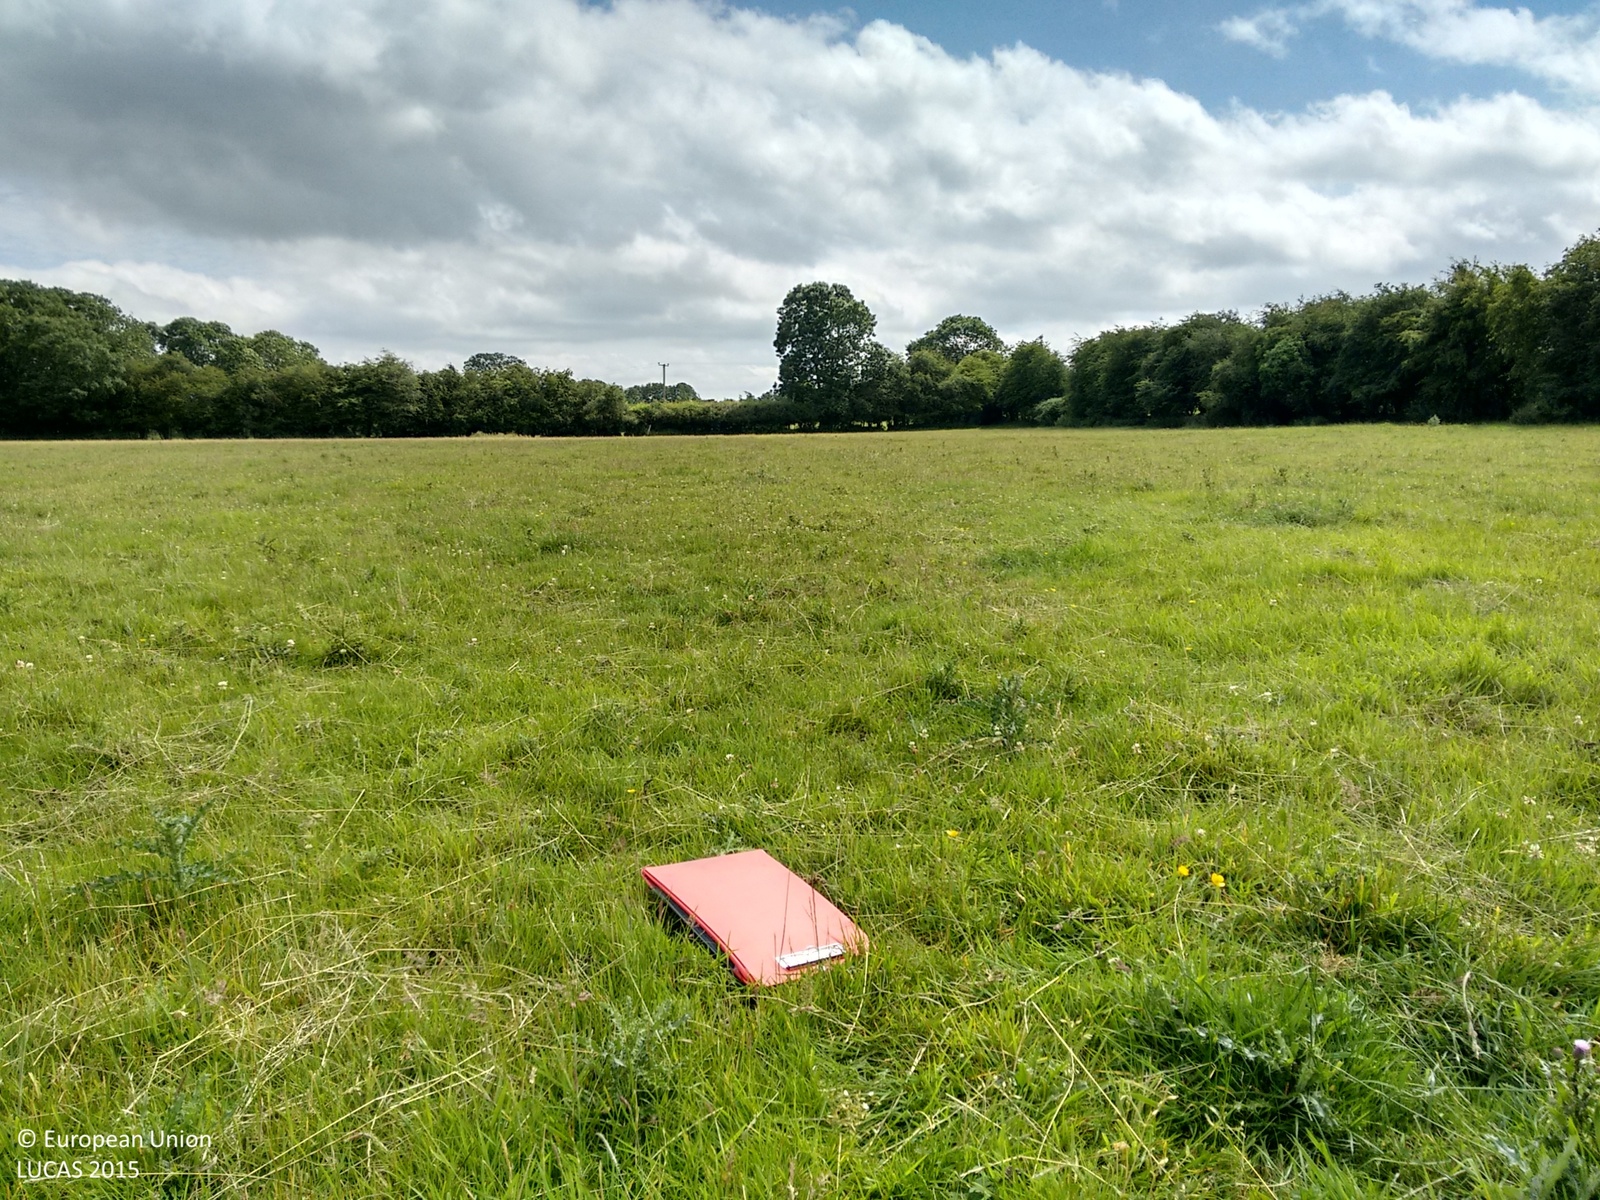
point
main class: Grassland
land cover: Grassland without tree/shrub cover
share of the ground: > 75 %
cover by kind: herbaceous plants 100 %
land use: Agriculture (excluding fallow land and kitchen gardens)
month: July
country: IE
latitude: 53.0827
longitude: -6.7817
